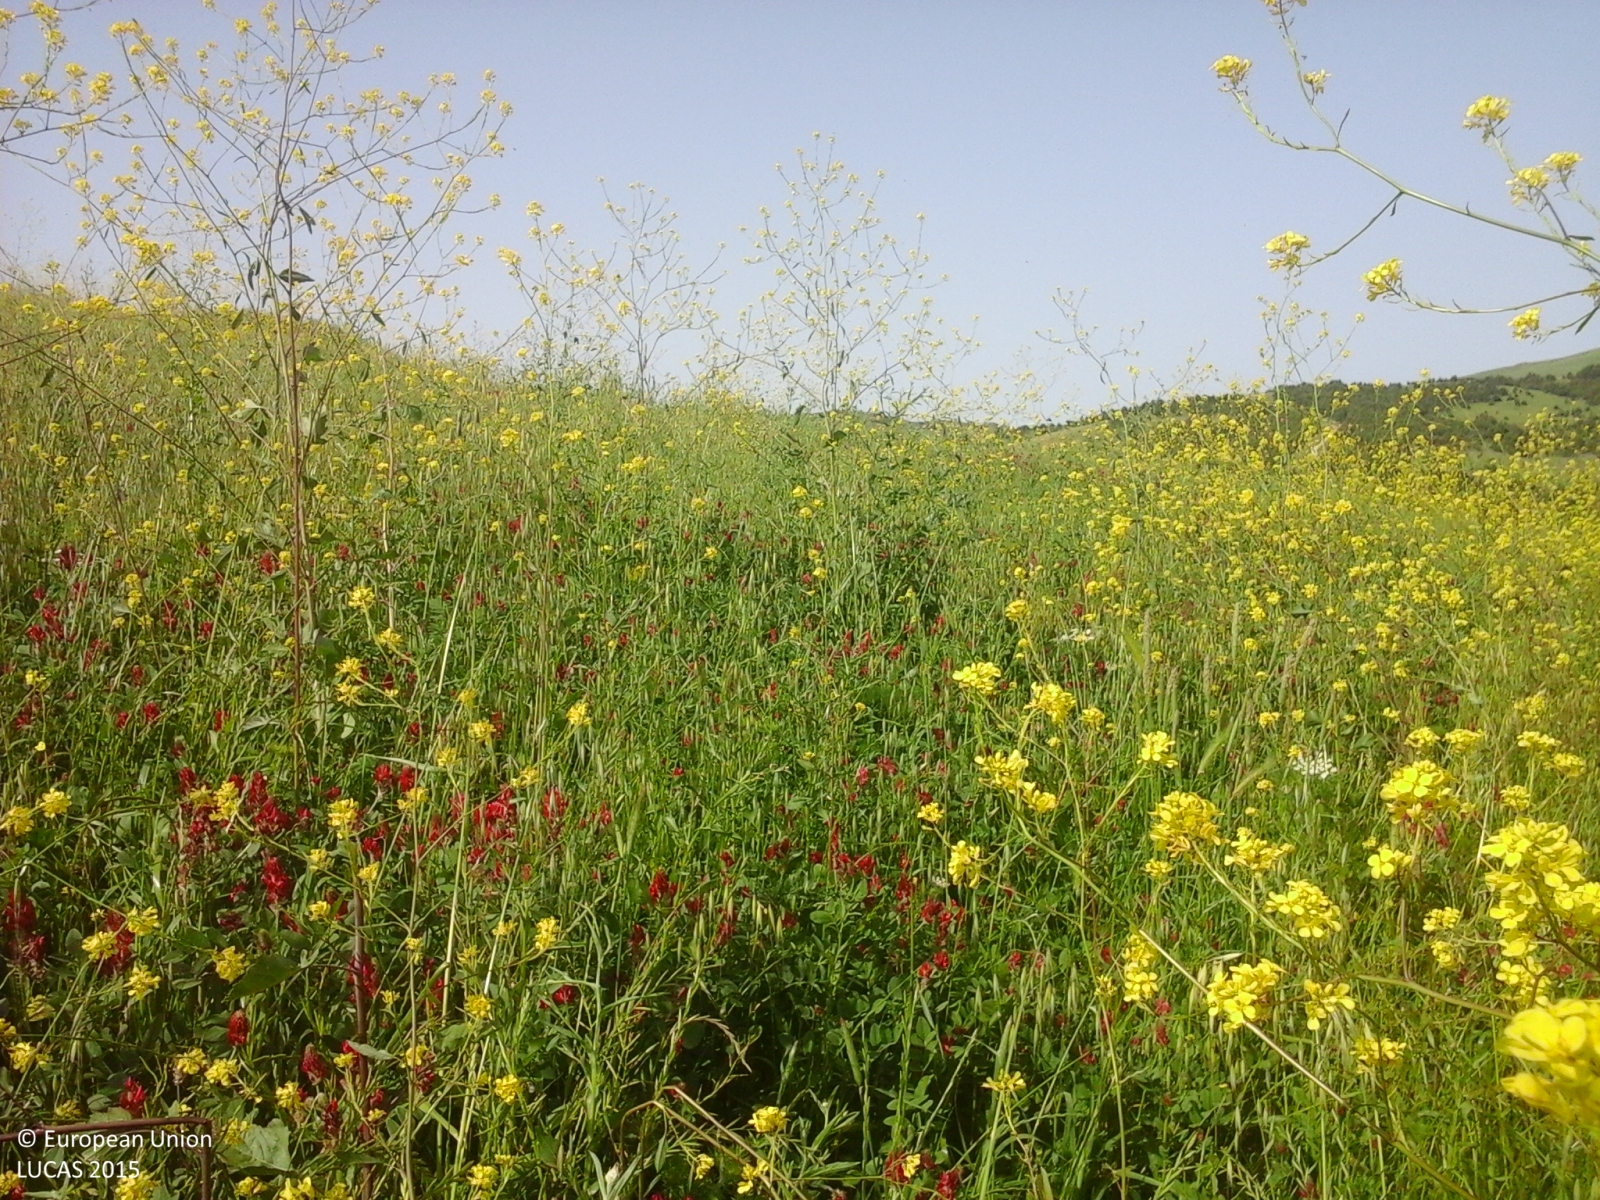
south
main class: Cropland
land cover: Temporary grasslands
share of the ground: > 75 %
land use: Agriculture (excluding fallow land and kitchen gardens)
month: May
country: IT
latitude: 37.7303
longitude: 14.1344
